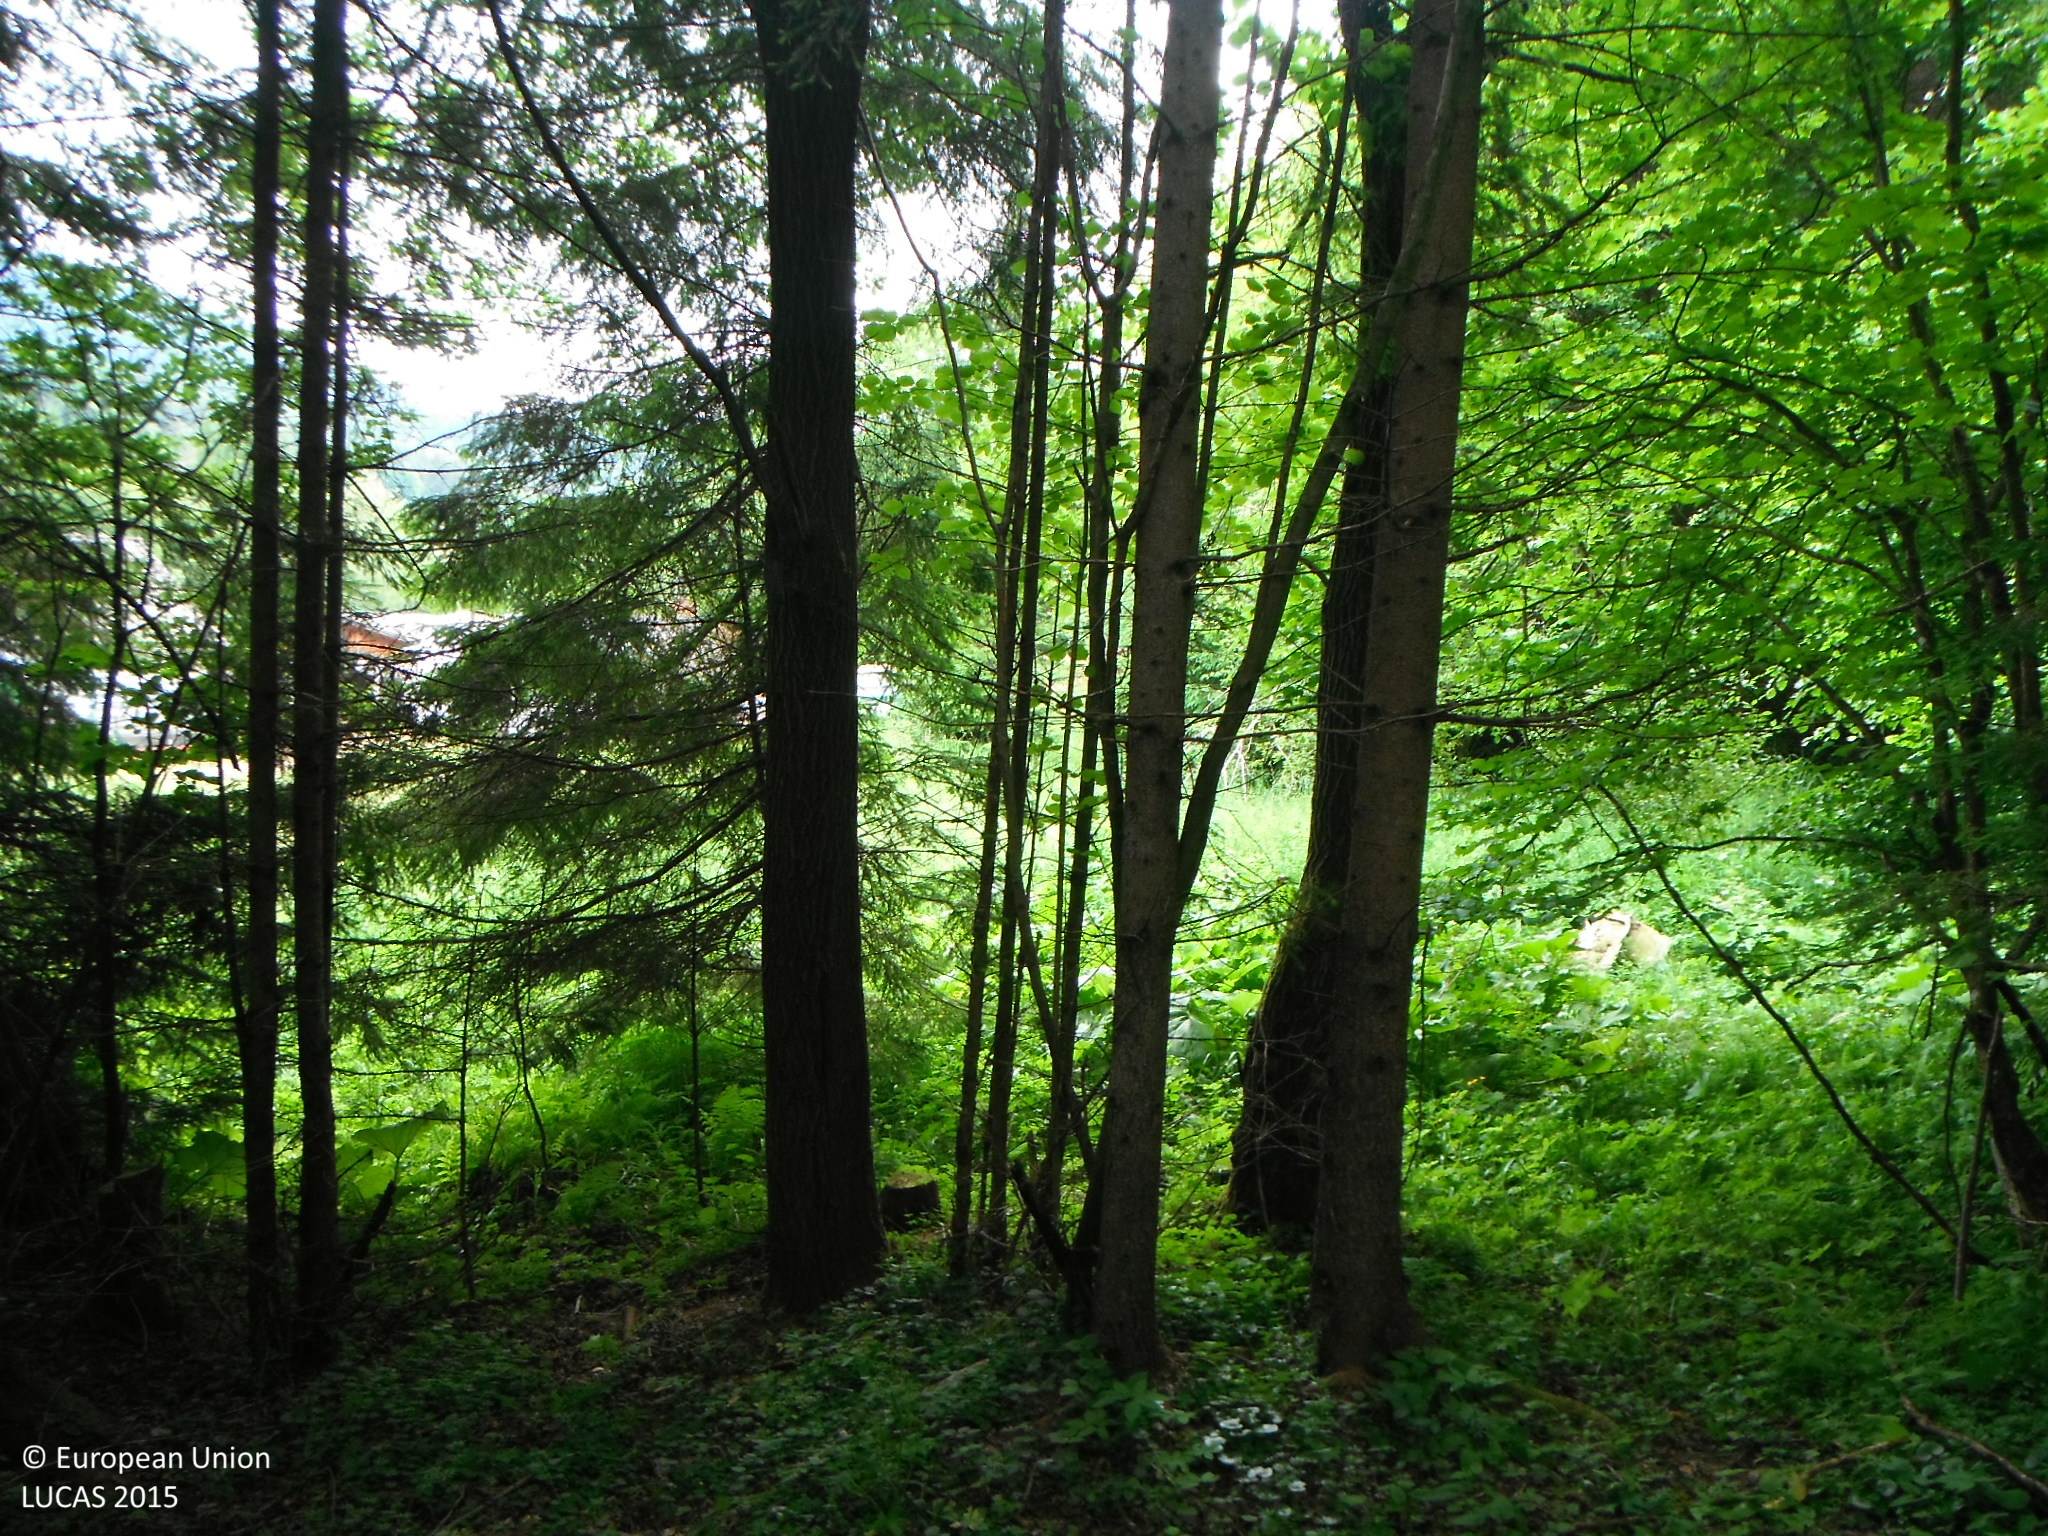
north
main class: Woodland
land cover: Spruce dominated mixed woodland
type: hemiboreal forest and nemoral coniferous forest and mixed broadleaved-coniferous forest
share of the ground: > 75 %
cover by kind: broadleaved forest trees 70 %, coniferous forest trees 30 %
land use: Forestry
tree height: > 5 m
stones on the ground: < 10 %
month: June
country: SK
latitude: 48.6516
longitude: 19.4316
